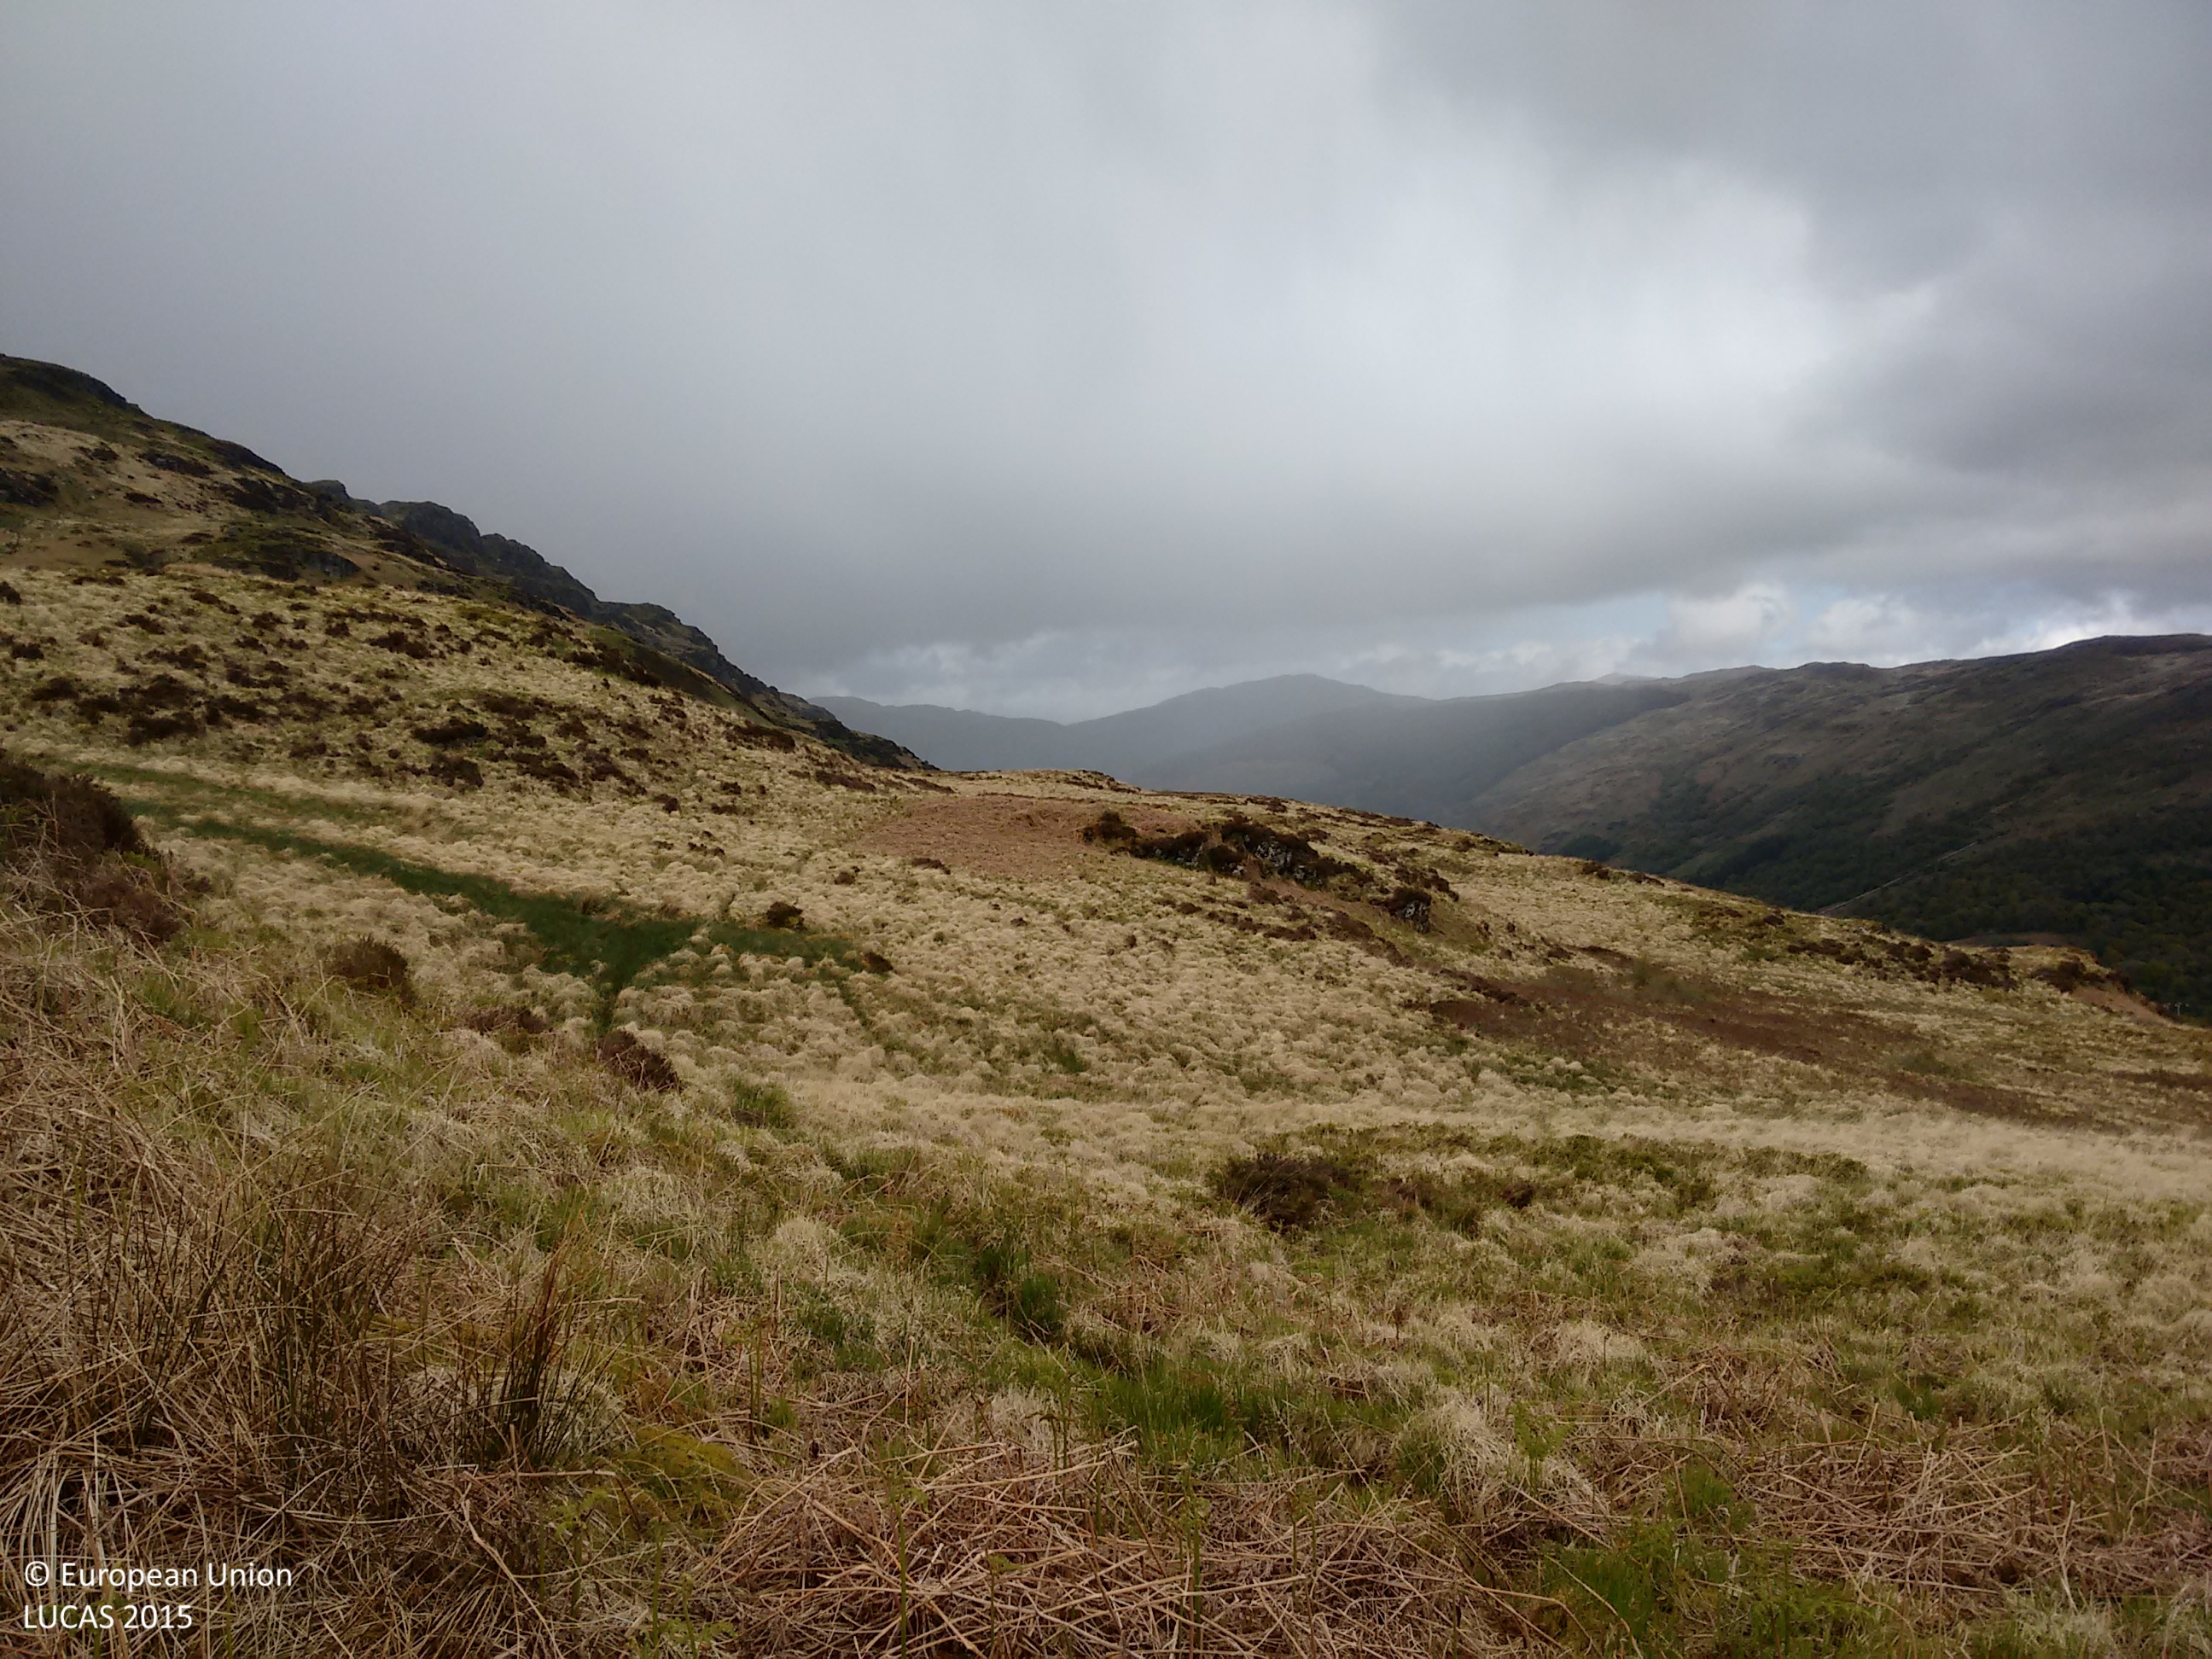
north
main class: Grassland
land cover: Grassland without tree/shrub cover
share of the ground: > 75 %
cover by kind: herbaceous plants 100 %
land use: Semi-natural and natural areas not in use
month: May
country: GB
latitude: 55.9972
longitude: -5.1367
